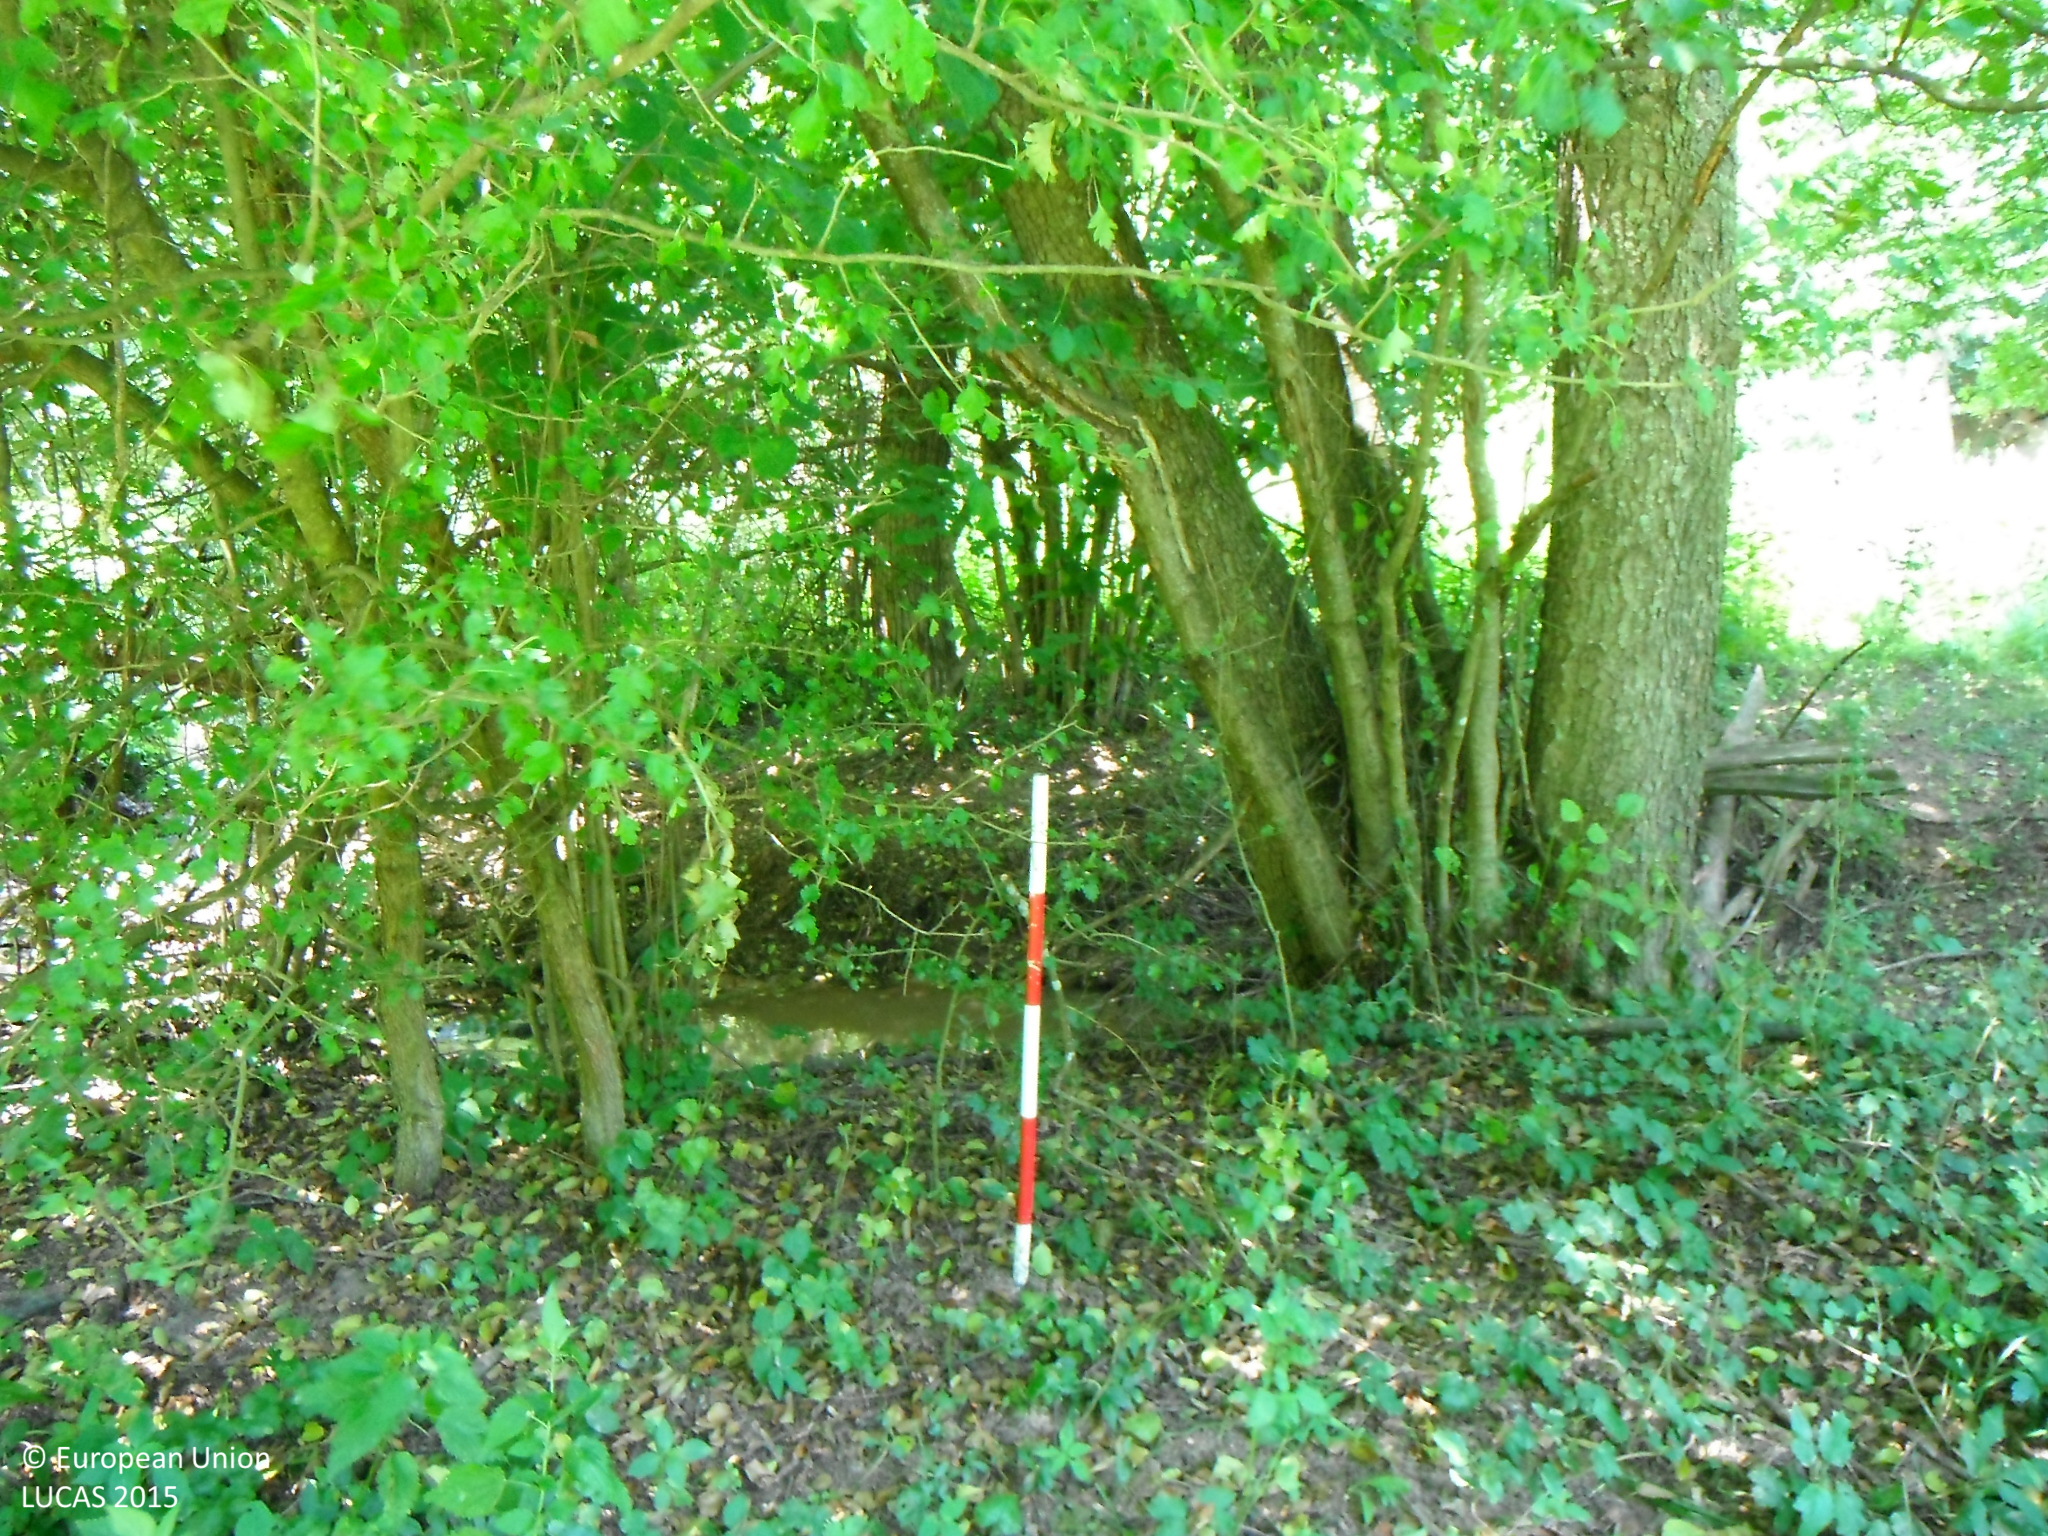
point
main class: Woodland
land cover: Broadleaved woodland
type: floodplain forest
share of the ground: > 75 %
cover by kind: broadleaved forest trees 100 %
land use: Forestry
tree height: > 5 m
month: July
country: SK
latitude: 48.2373
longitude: 19.1906
